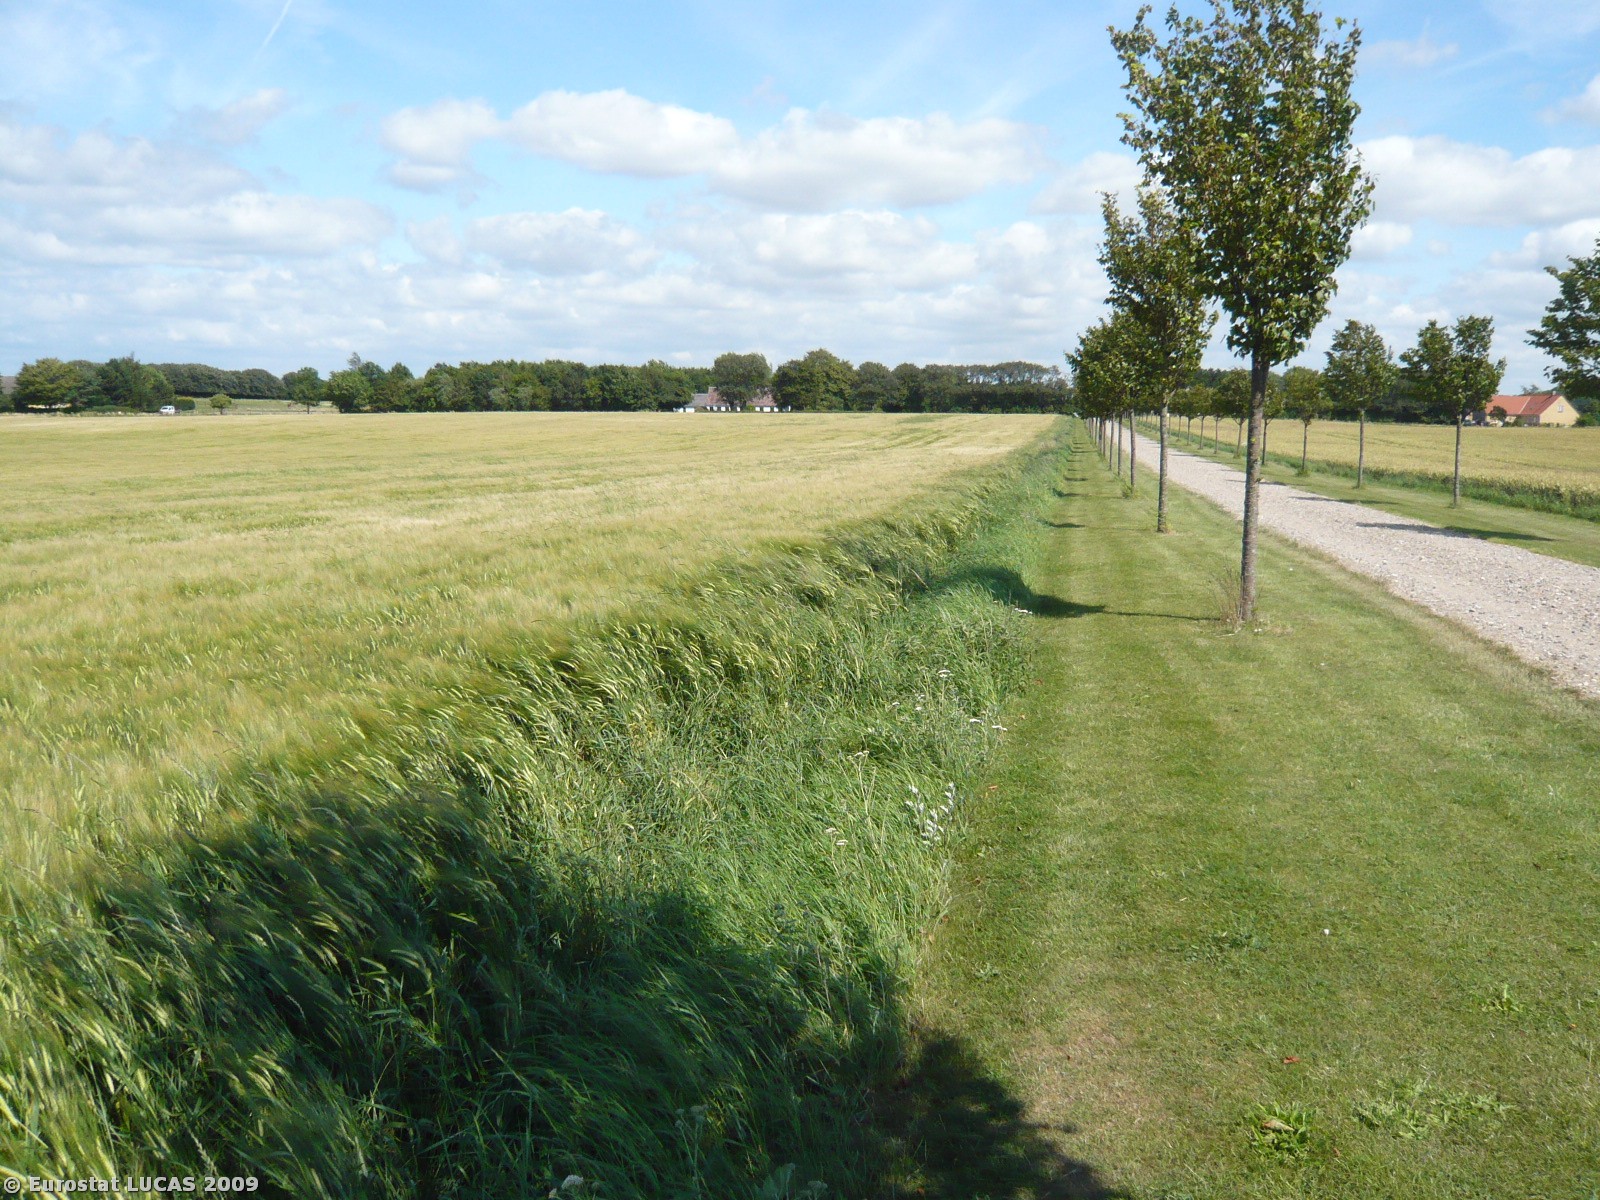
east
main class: Cropland
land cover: Barley
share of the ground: > 75 %
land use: Agriculture (excluding fallow land and kitchen gardens)
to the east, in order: Barley
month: July
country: DK
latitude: 55.6974
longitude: 11.1285
